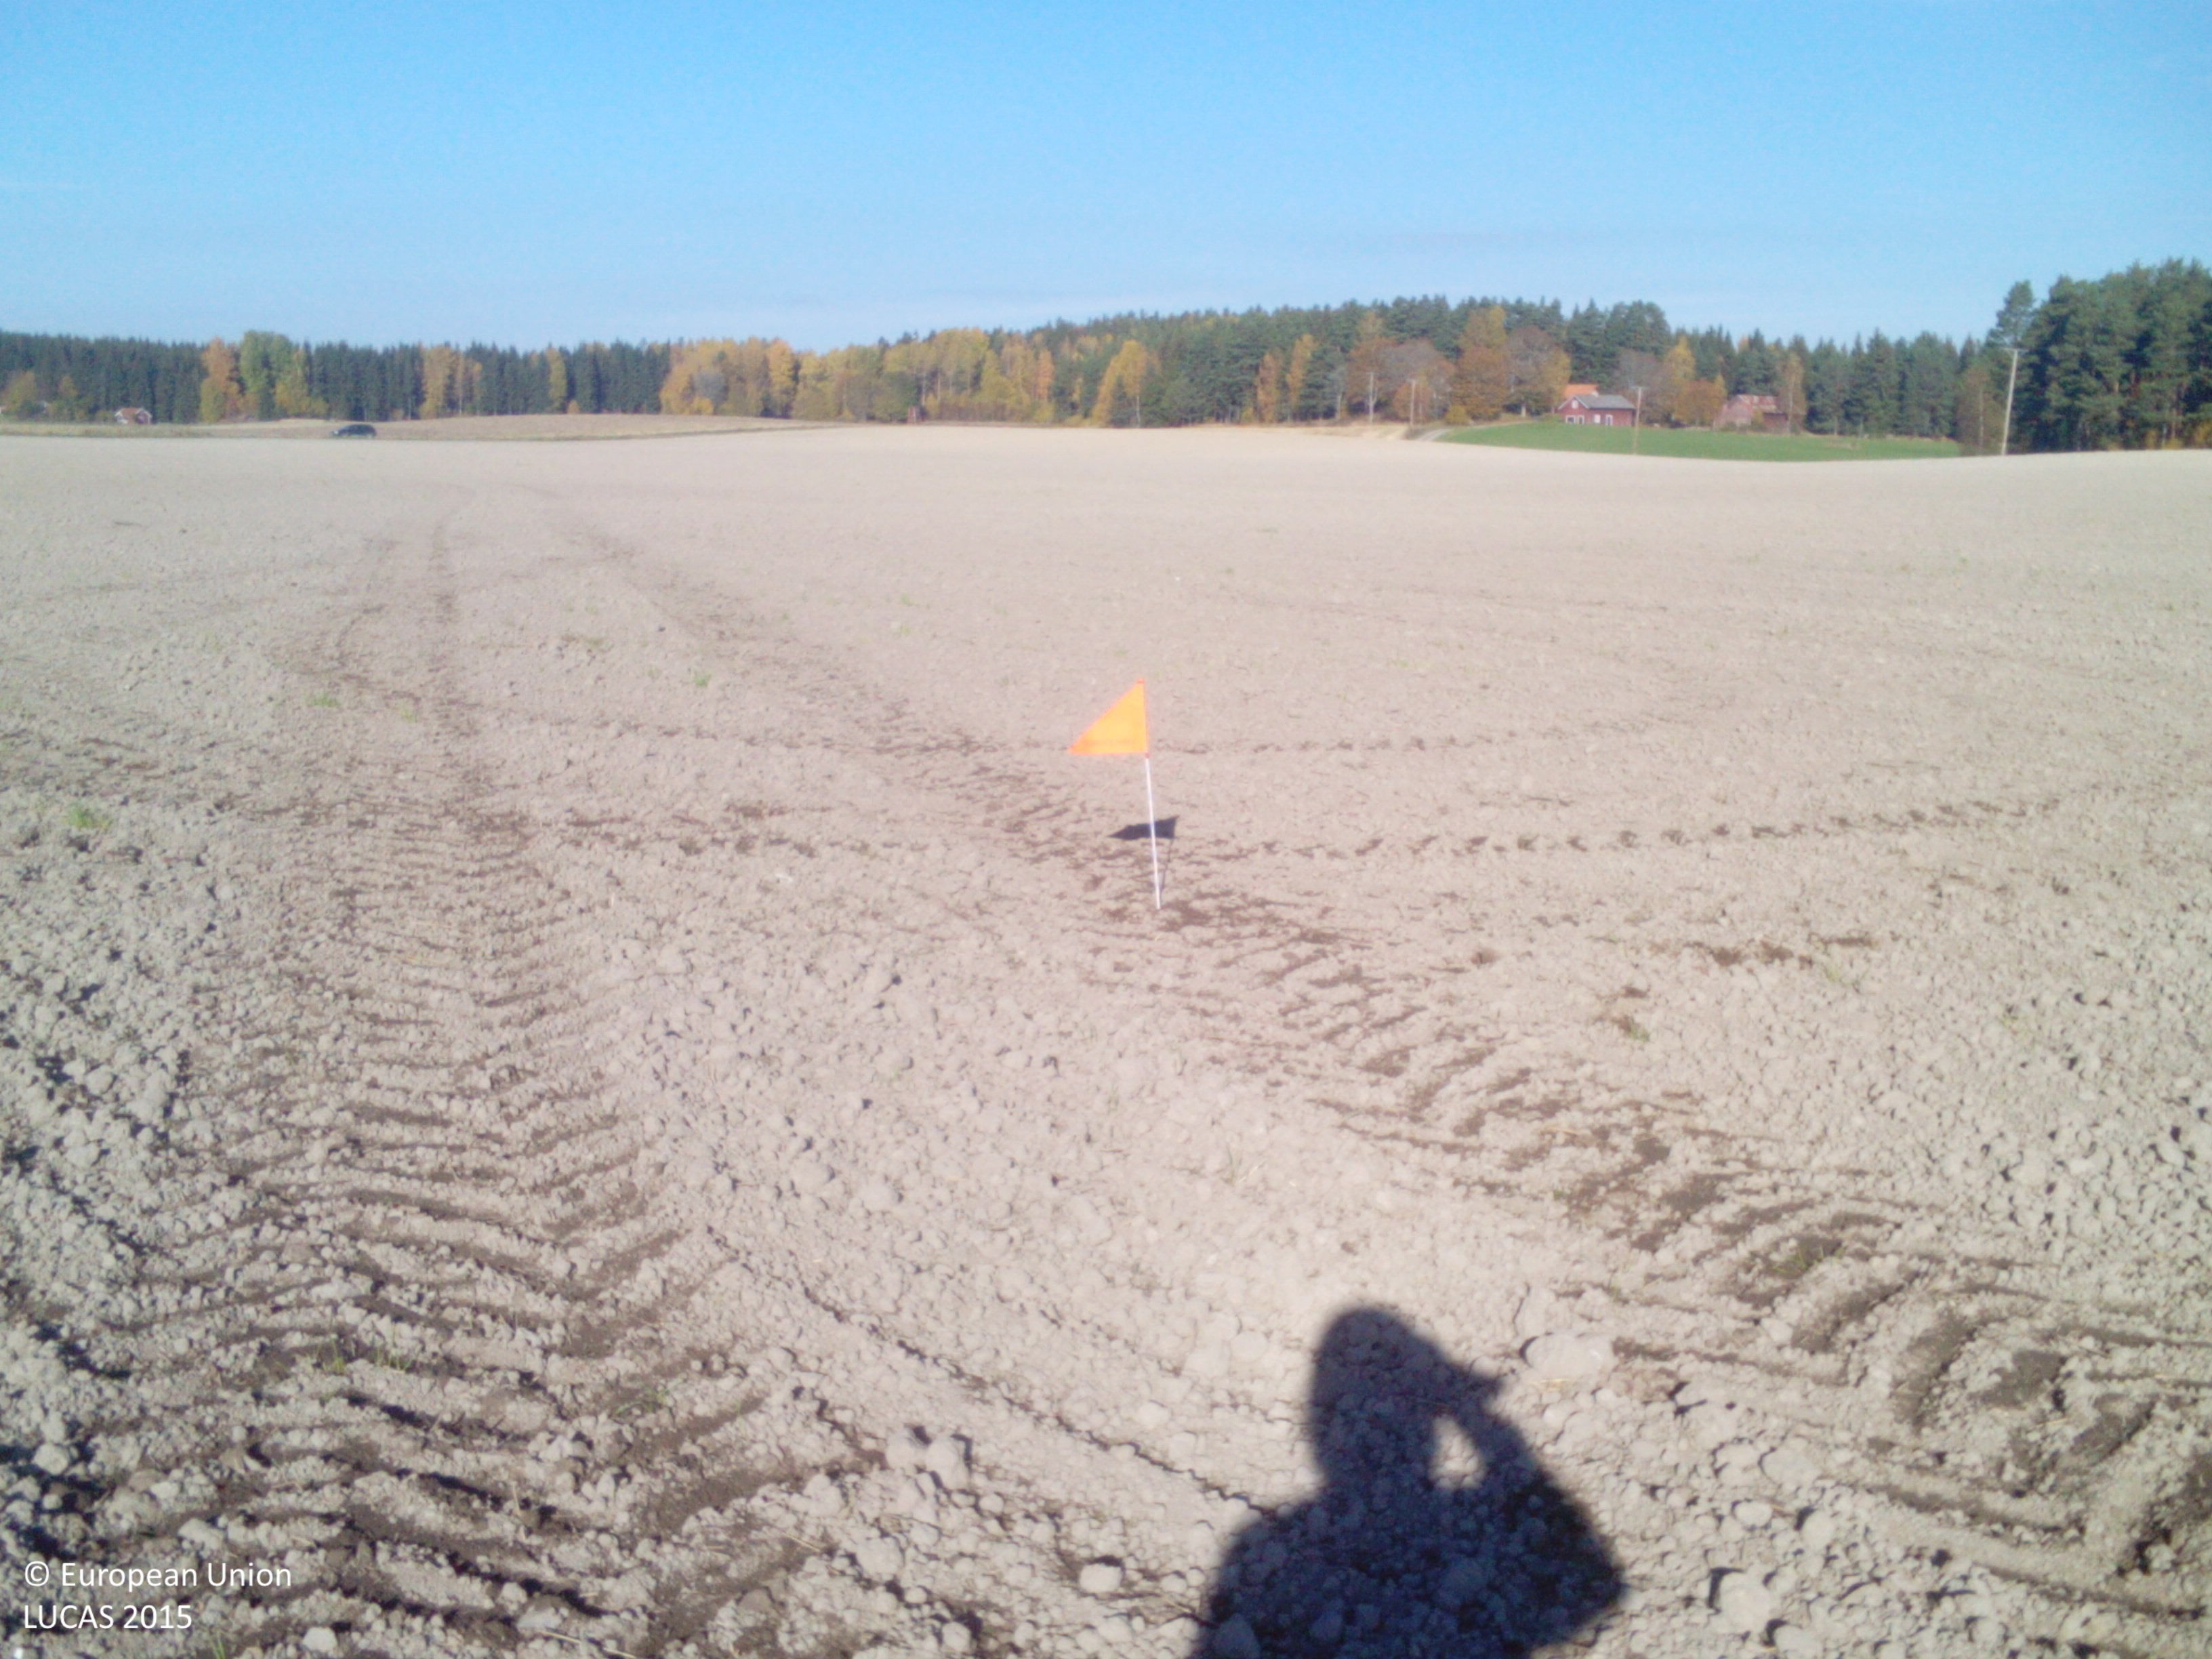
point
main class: Cropland
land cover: Common wheat
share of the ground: < 10 %
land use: Agriculture (excluding fallow land and kitchen gardens)
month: October
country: SE
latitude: 58.9106
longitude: 16.5056
